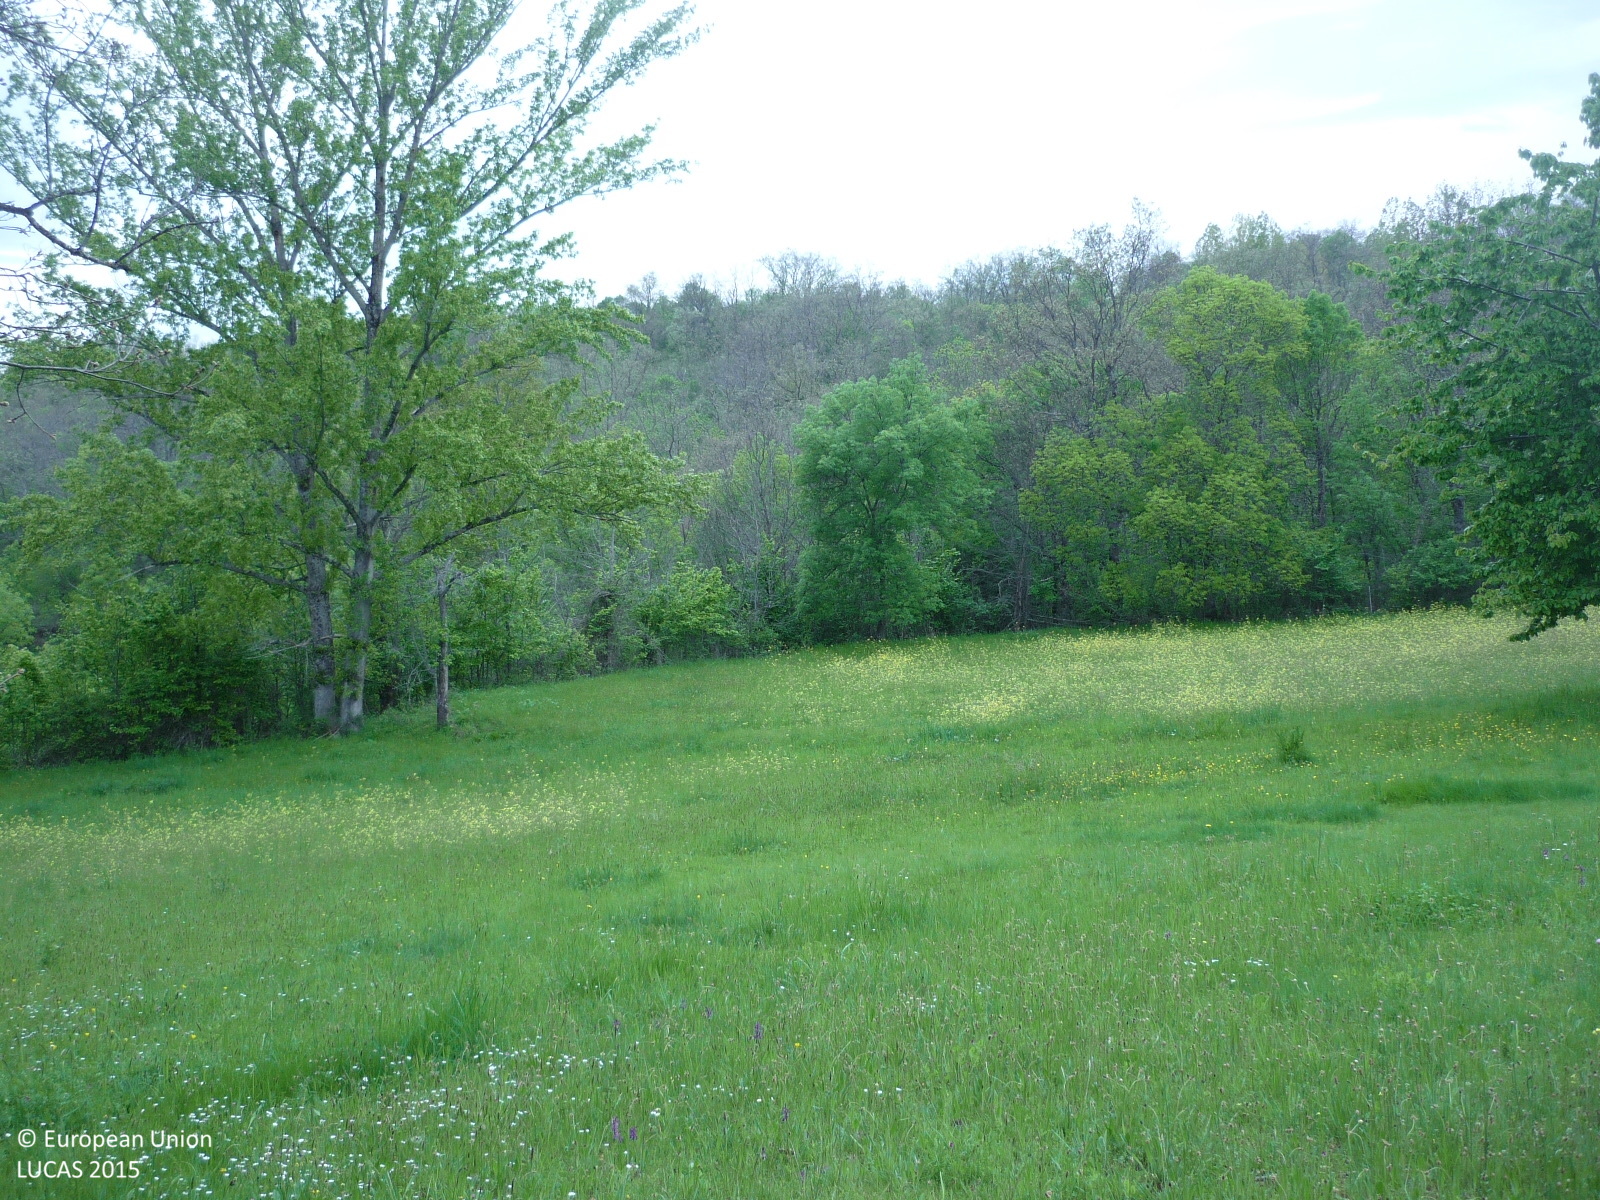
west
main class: Grassland
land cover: Grassland without tree/shrub cover
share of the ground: > 75 %
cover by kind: herbaceous plants 100 %
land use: Agriculture (excluding fallow land and kitchen gardens)
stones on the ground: < 10 %
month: May
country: ES
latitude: 41.0652
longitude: -3.5262
